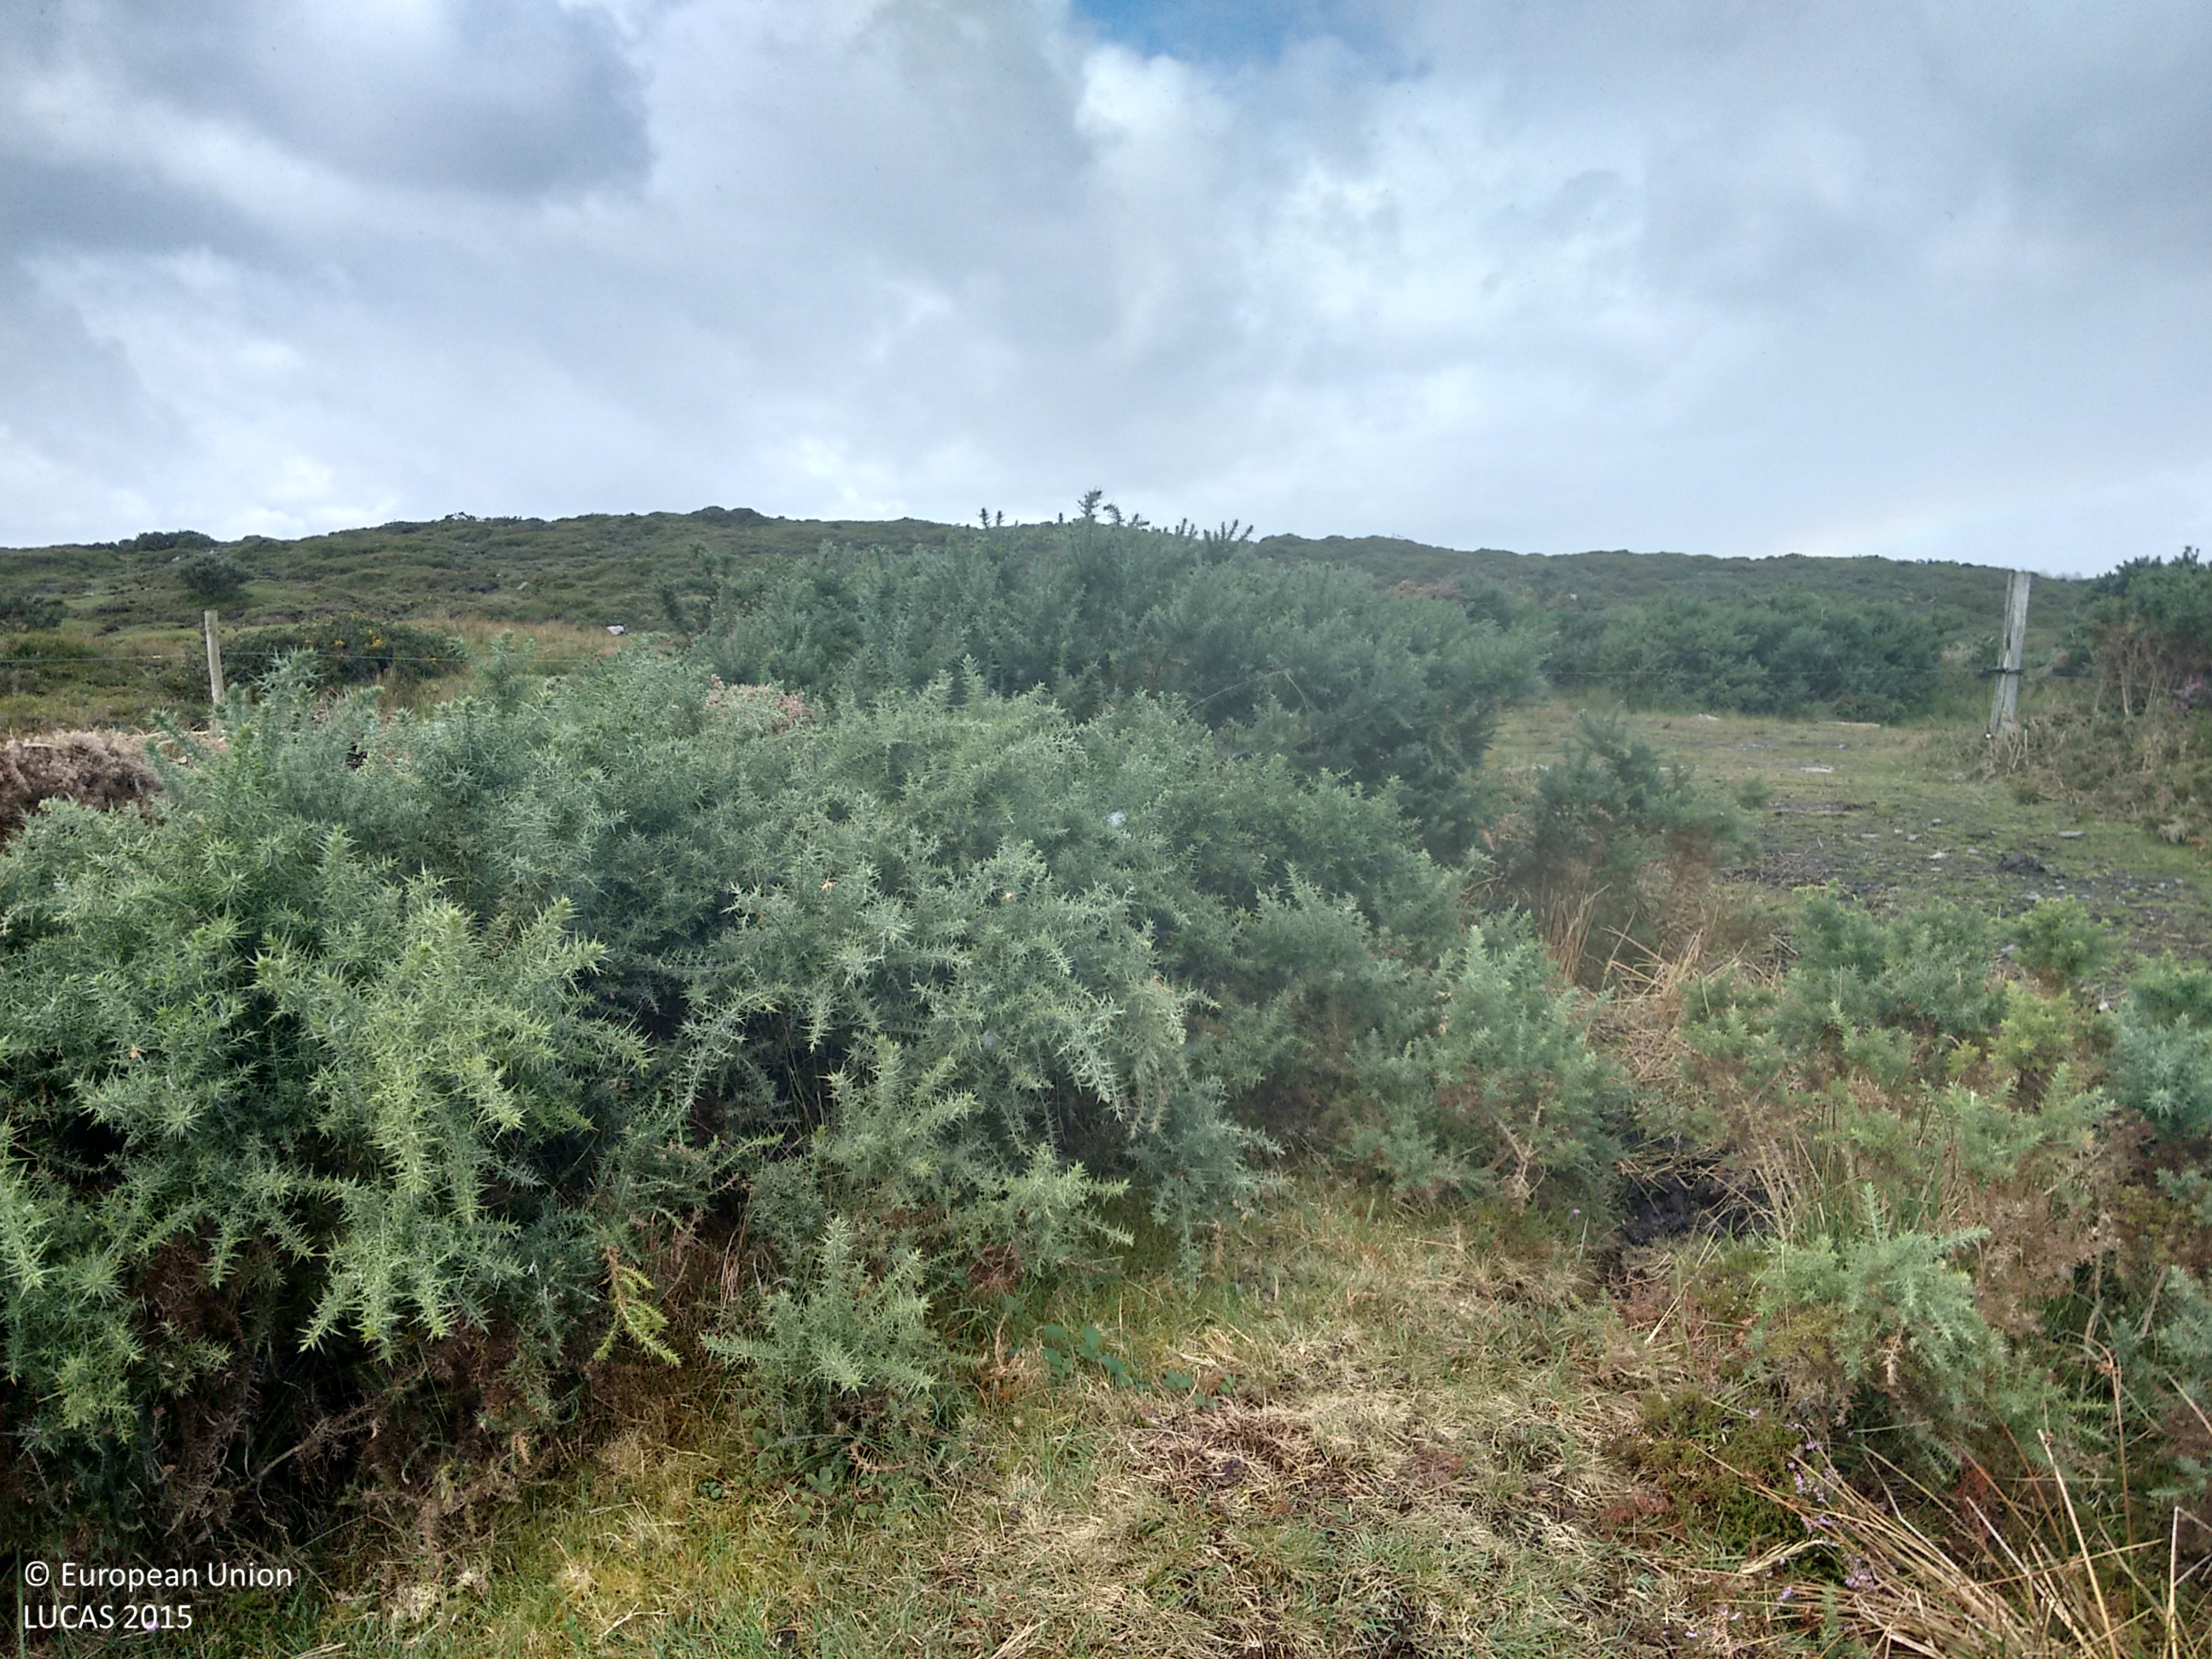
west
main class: Grassland
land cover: Grassland with sparse tree/shrub cover
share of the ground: > 75 %
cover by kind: herbaceous plants 85 %, shrubs 10 %, broadleaved forest trees 5 %
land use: Agriculture (excluding fallow land and kitchen gardens)
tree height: < 5 m
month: August
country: IE
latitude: 52.0610
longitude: -9.7747
